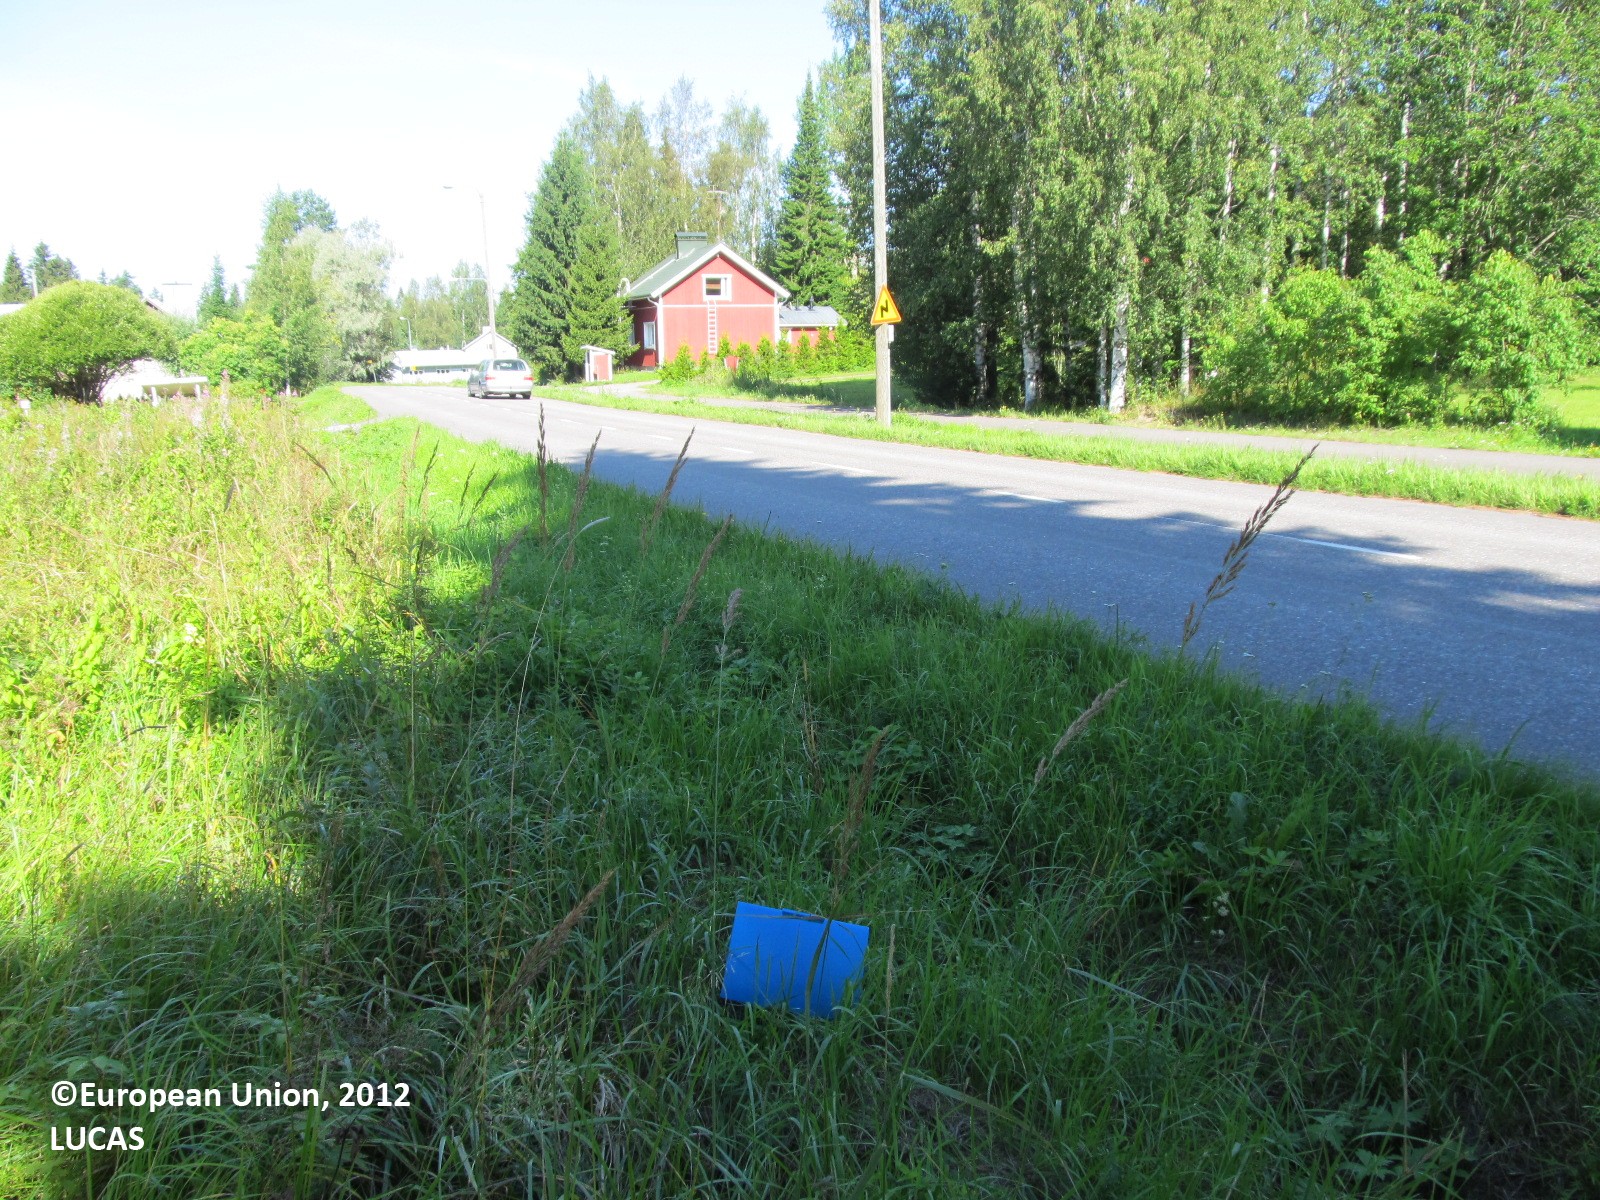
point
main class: Grassland
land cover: Spontaneously vegetated surfaces
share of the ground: > 75 %
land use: Road transport
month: August
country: FI
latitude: 62.3485
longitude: 27.8534
